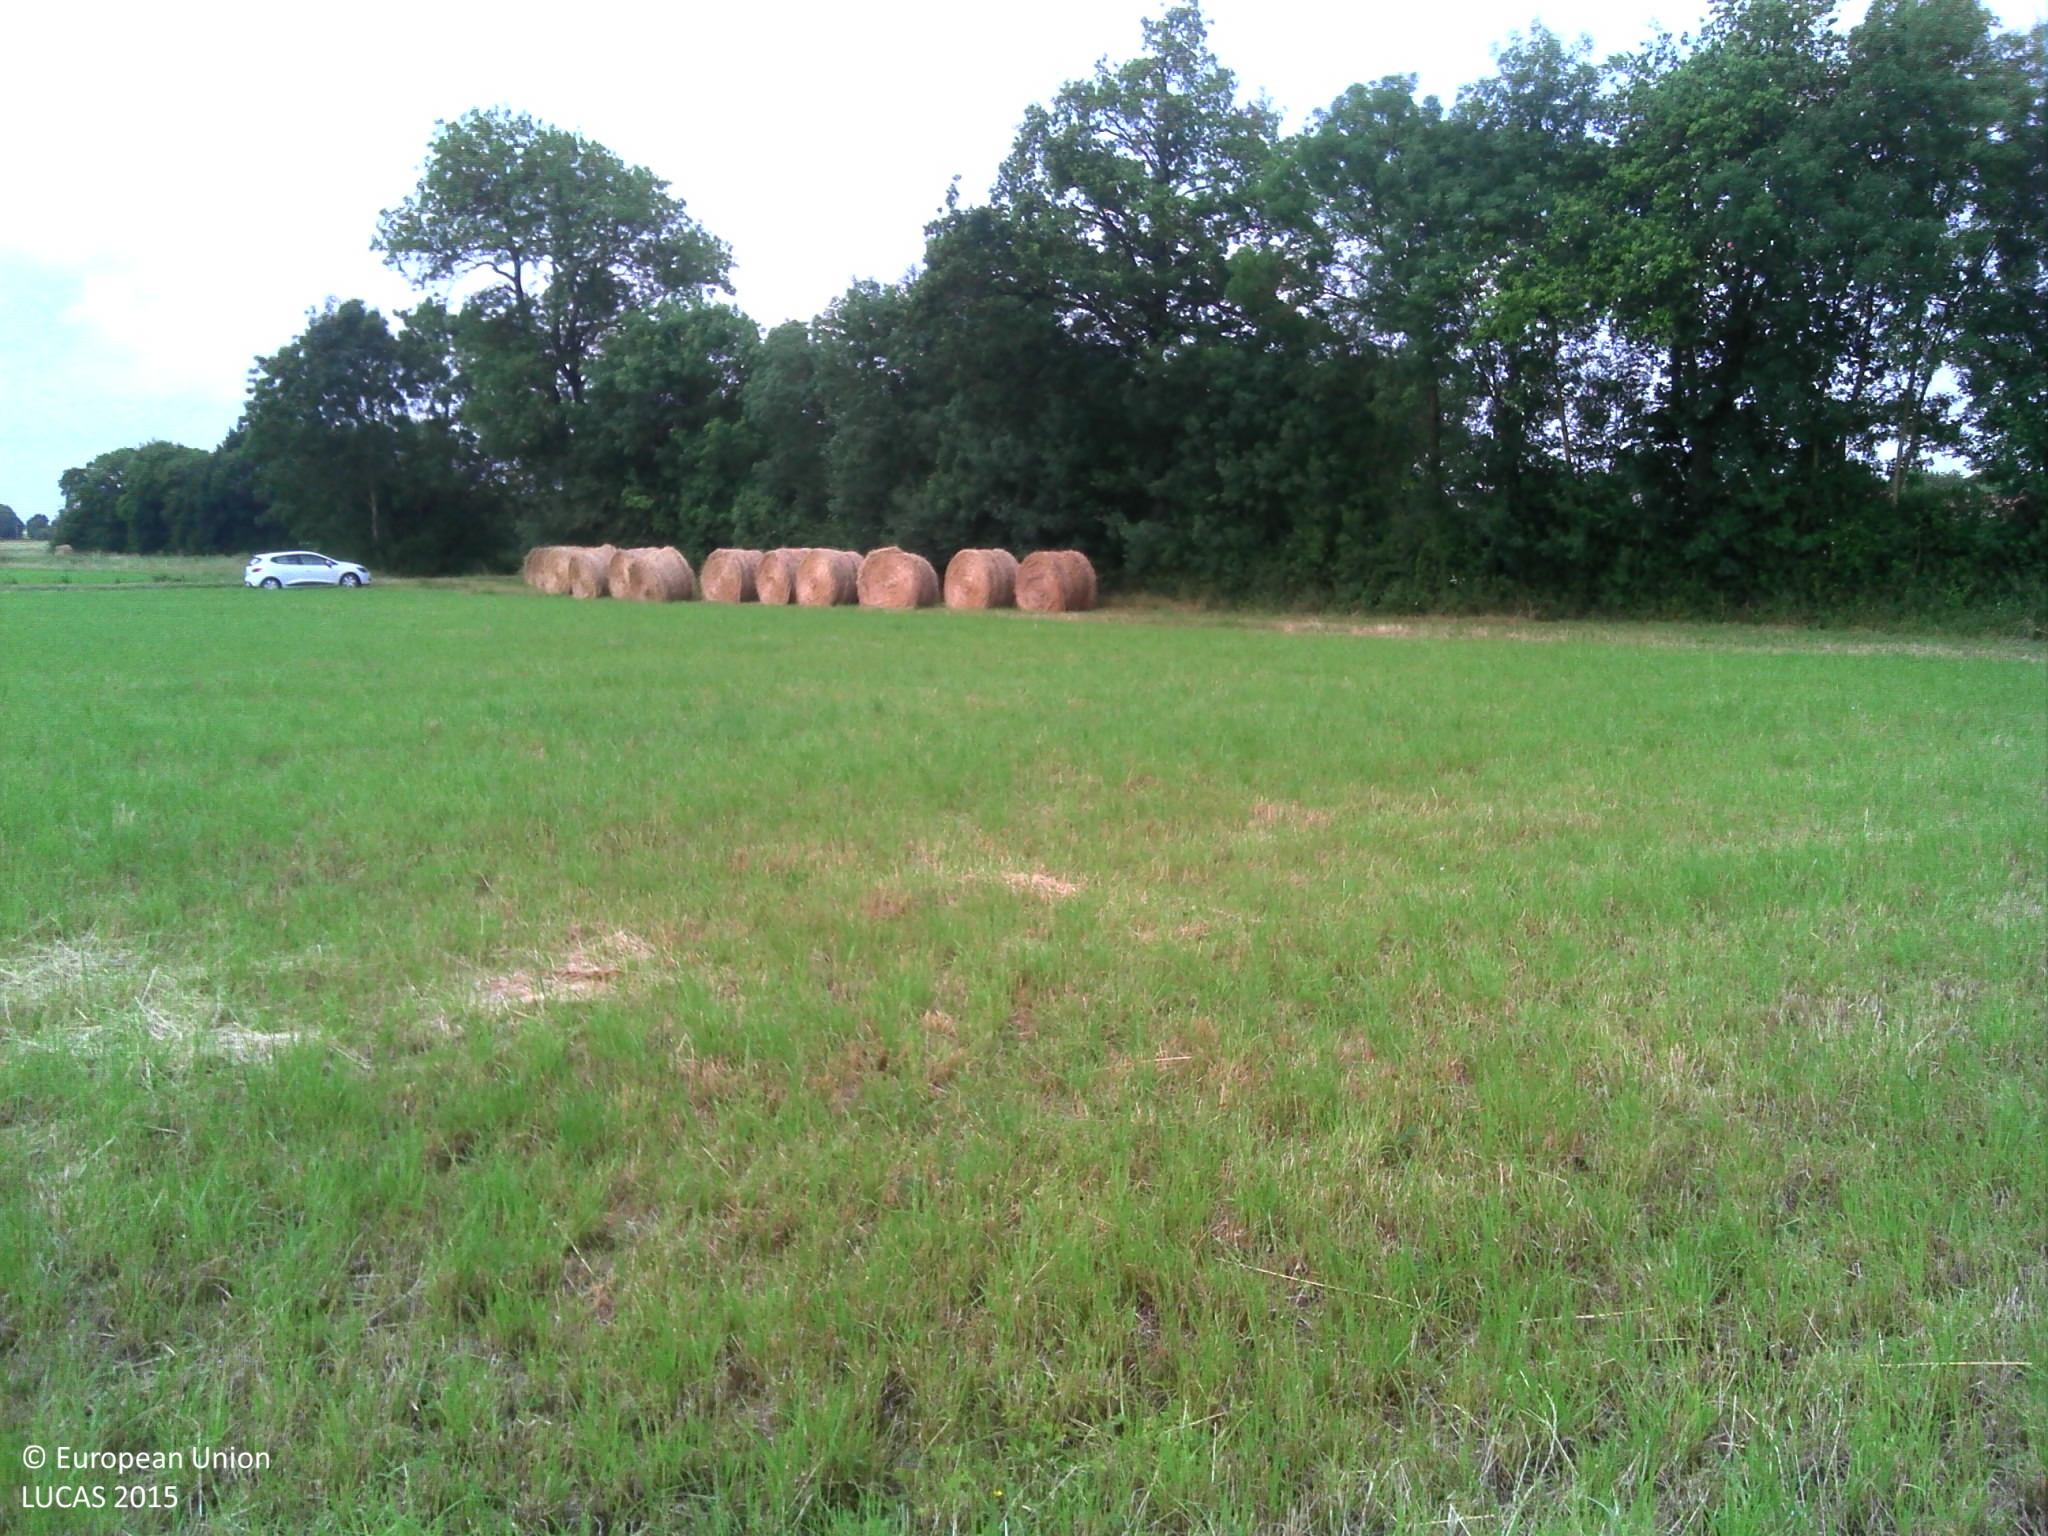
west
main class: Cropland
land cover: Temporary grasslands
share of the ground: > 75 %
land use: Agriculture (excluding fallow land and kitchen gardens)
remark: Harvested field
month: June
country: FR
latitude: 46.9243
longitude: -1.3718
